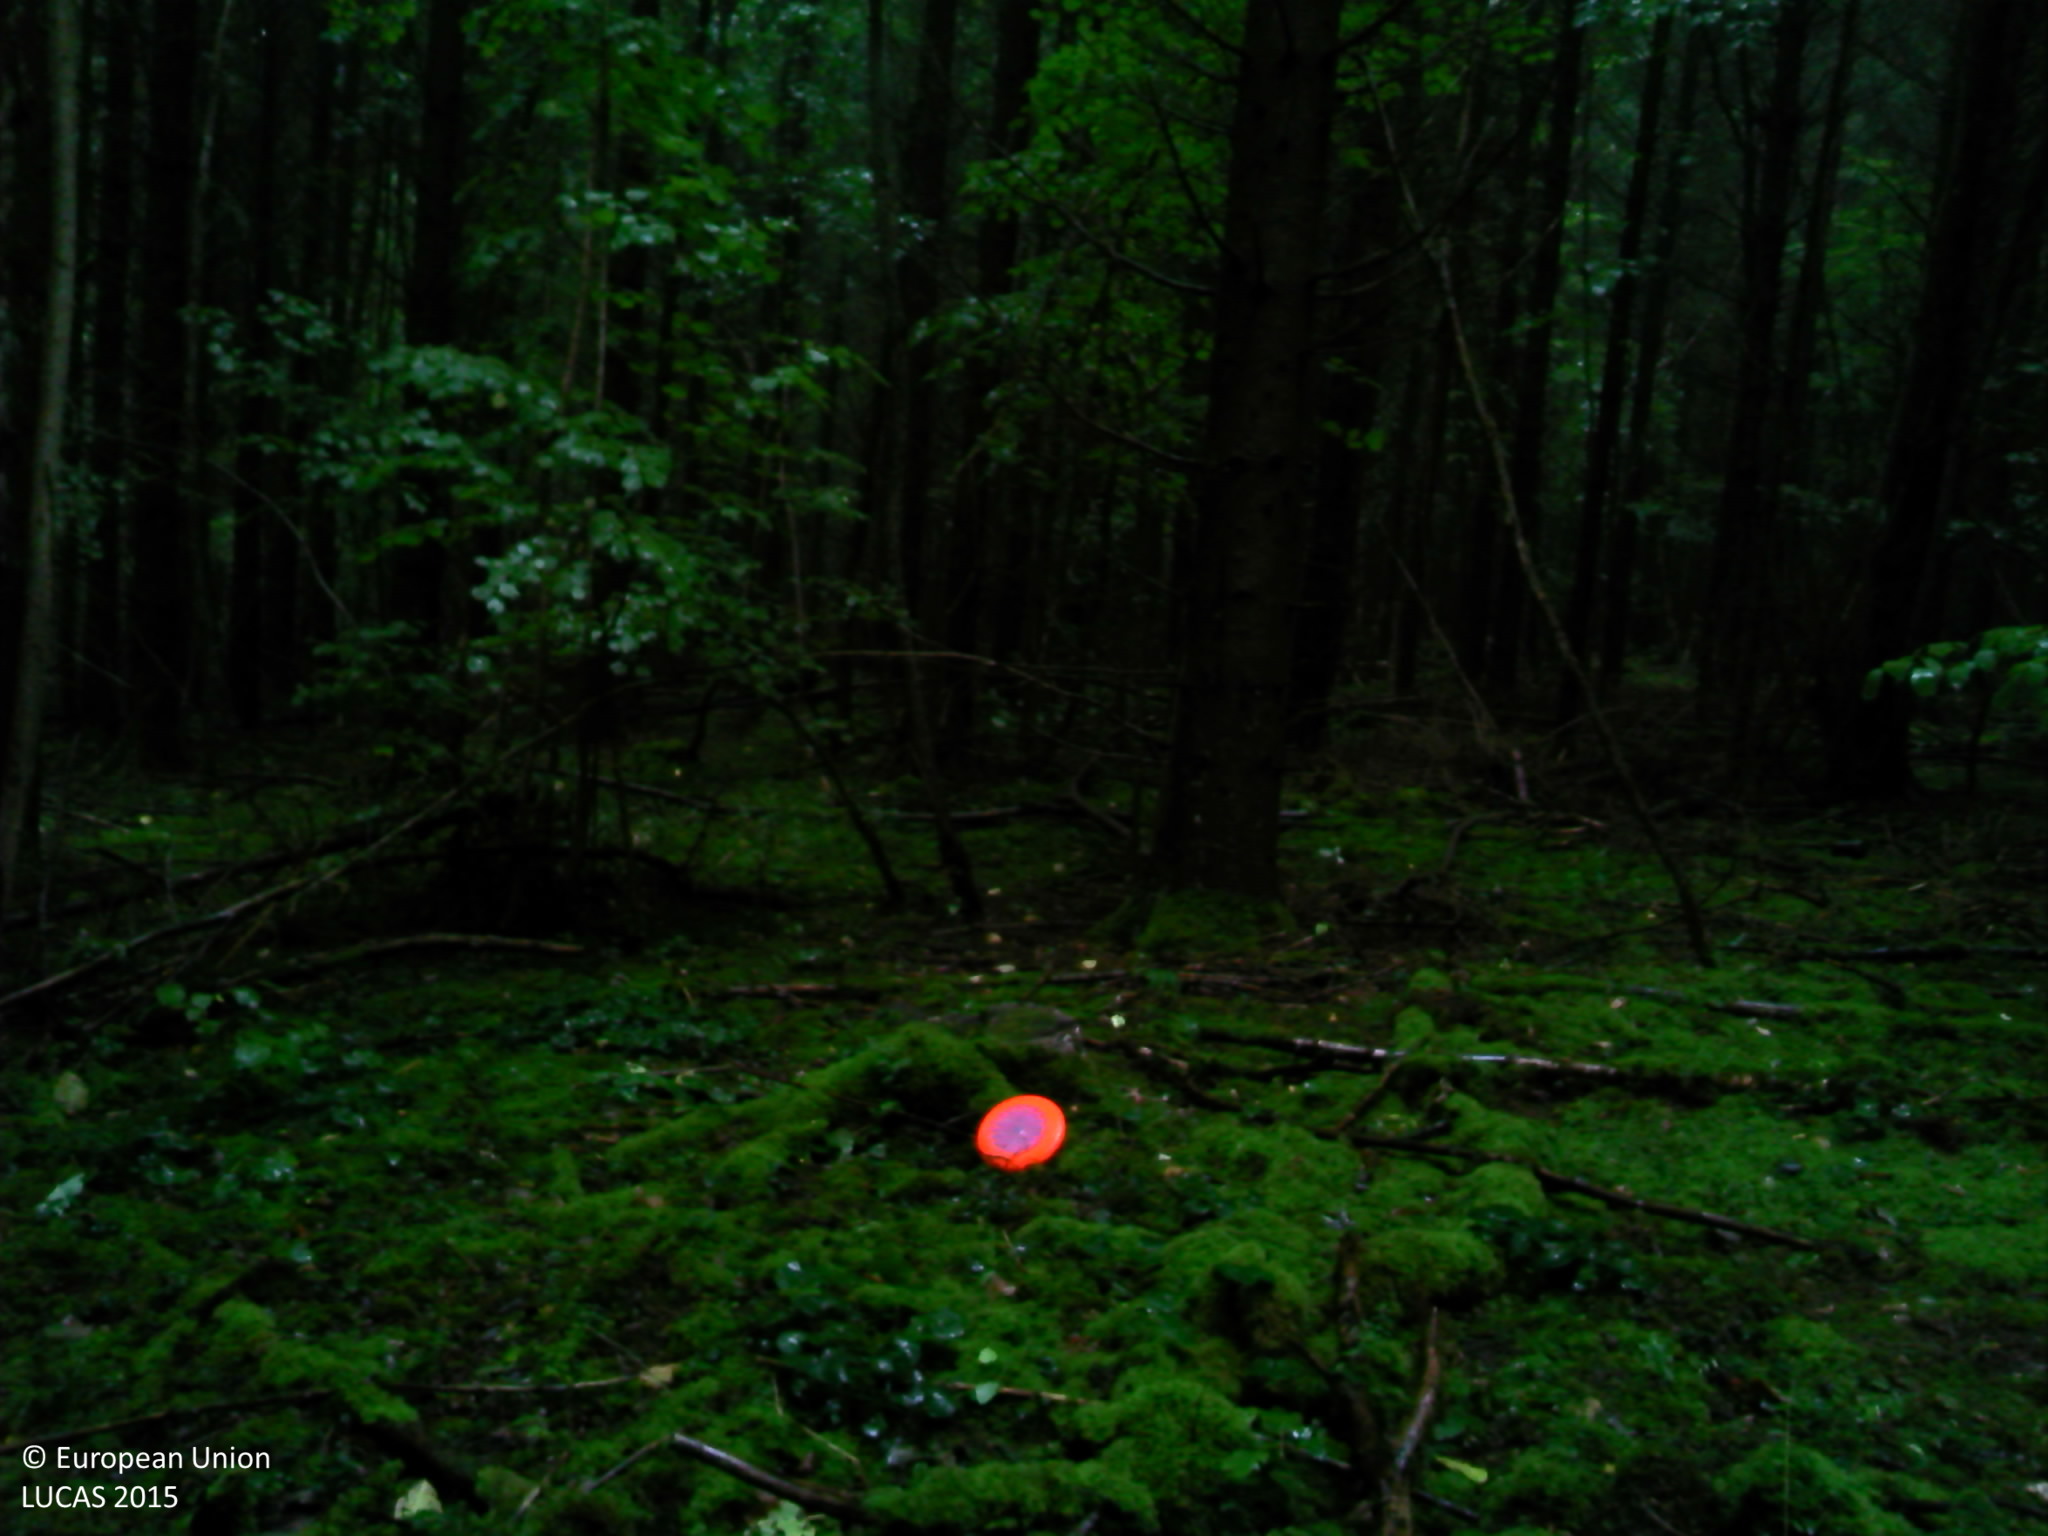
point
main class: Woodland
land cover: Spruce dominated mixed woodland
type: exotic forest
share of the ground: > 75 %
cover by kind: coniferous forest trees 60 %, broadleaved forest trees 30 %, consolidated bare surface 10 %
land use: Forestry
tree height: > 5 m
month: September
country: FR
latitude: 48.7130
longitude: 6.0994
